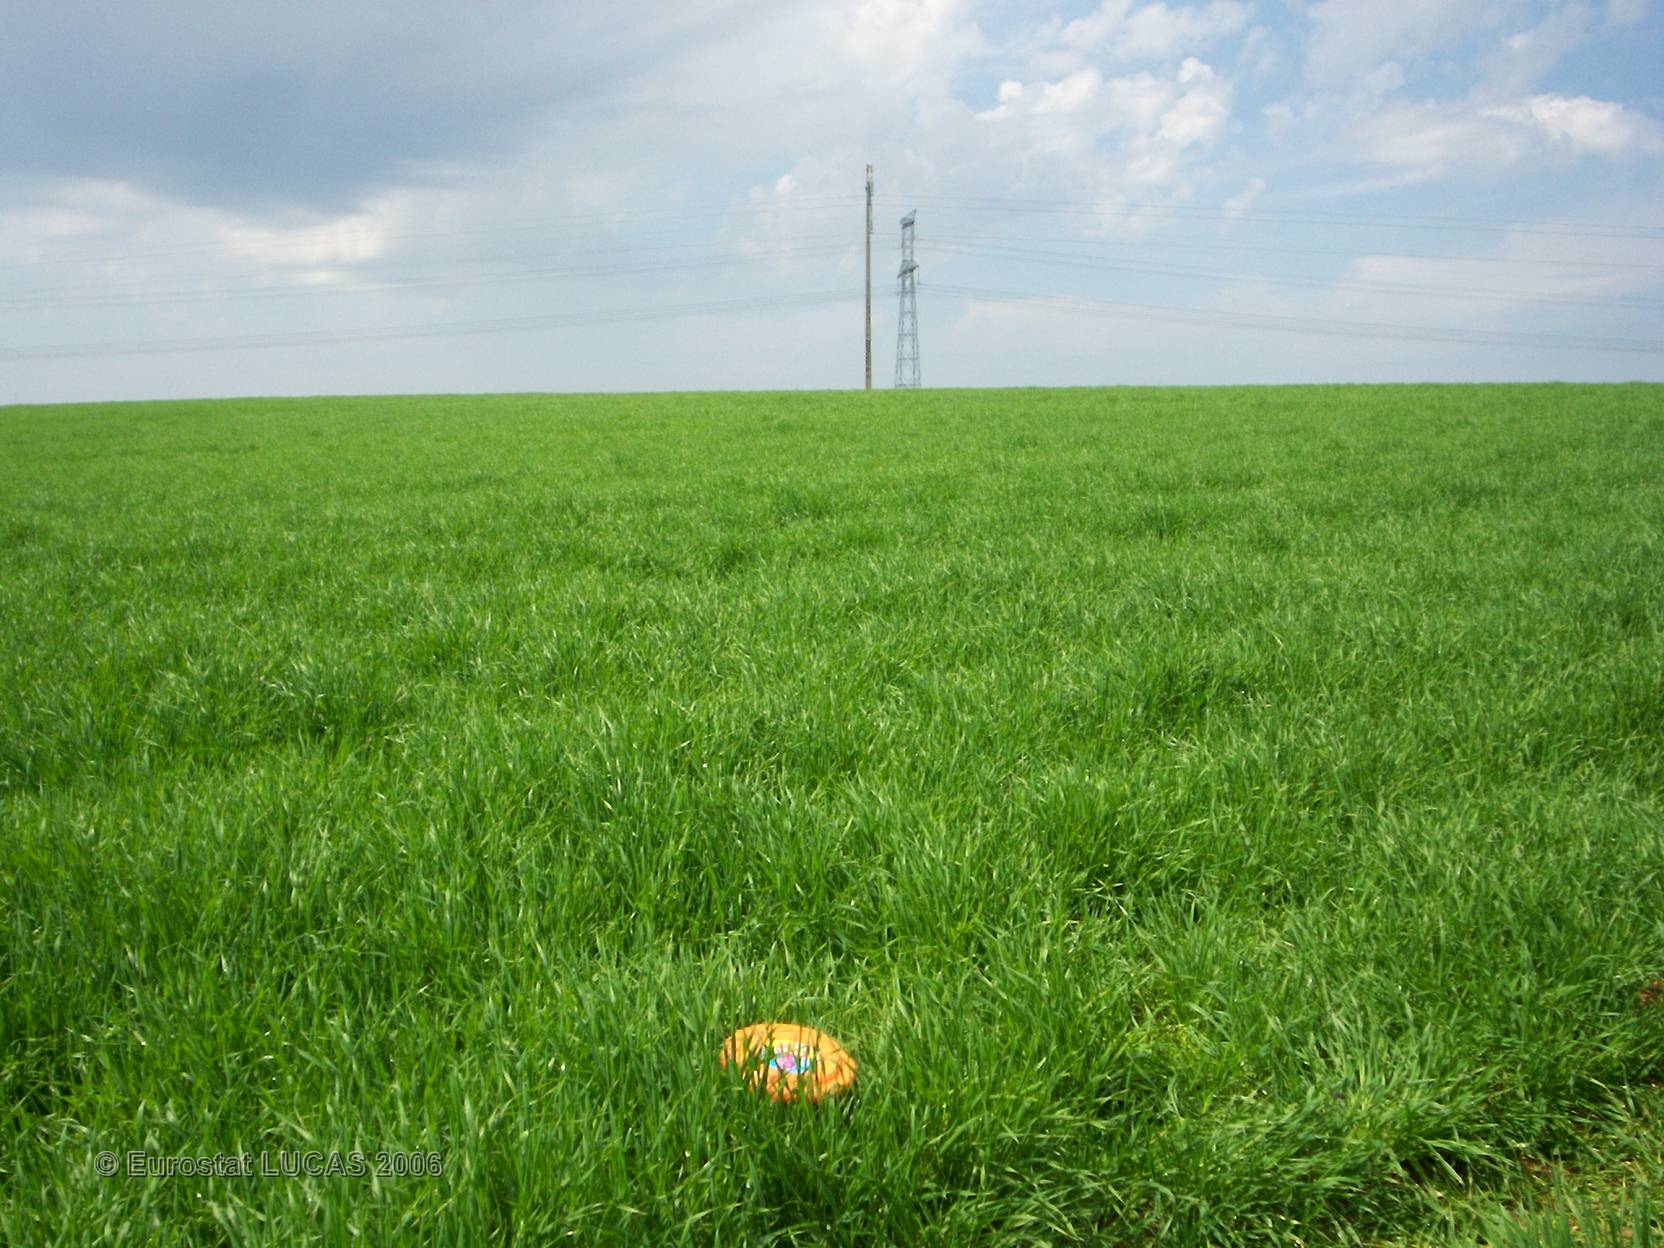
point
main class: Cropland
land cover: Barley
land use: Agriculture (excluding fallow land and kitchen gardens)
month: April
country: FR
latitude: 47.3339
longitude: 3.0207
